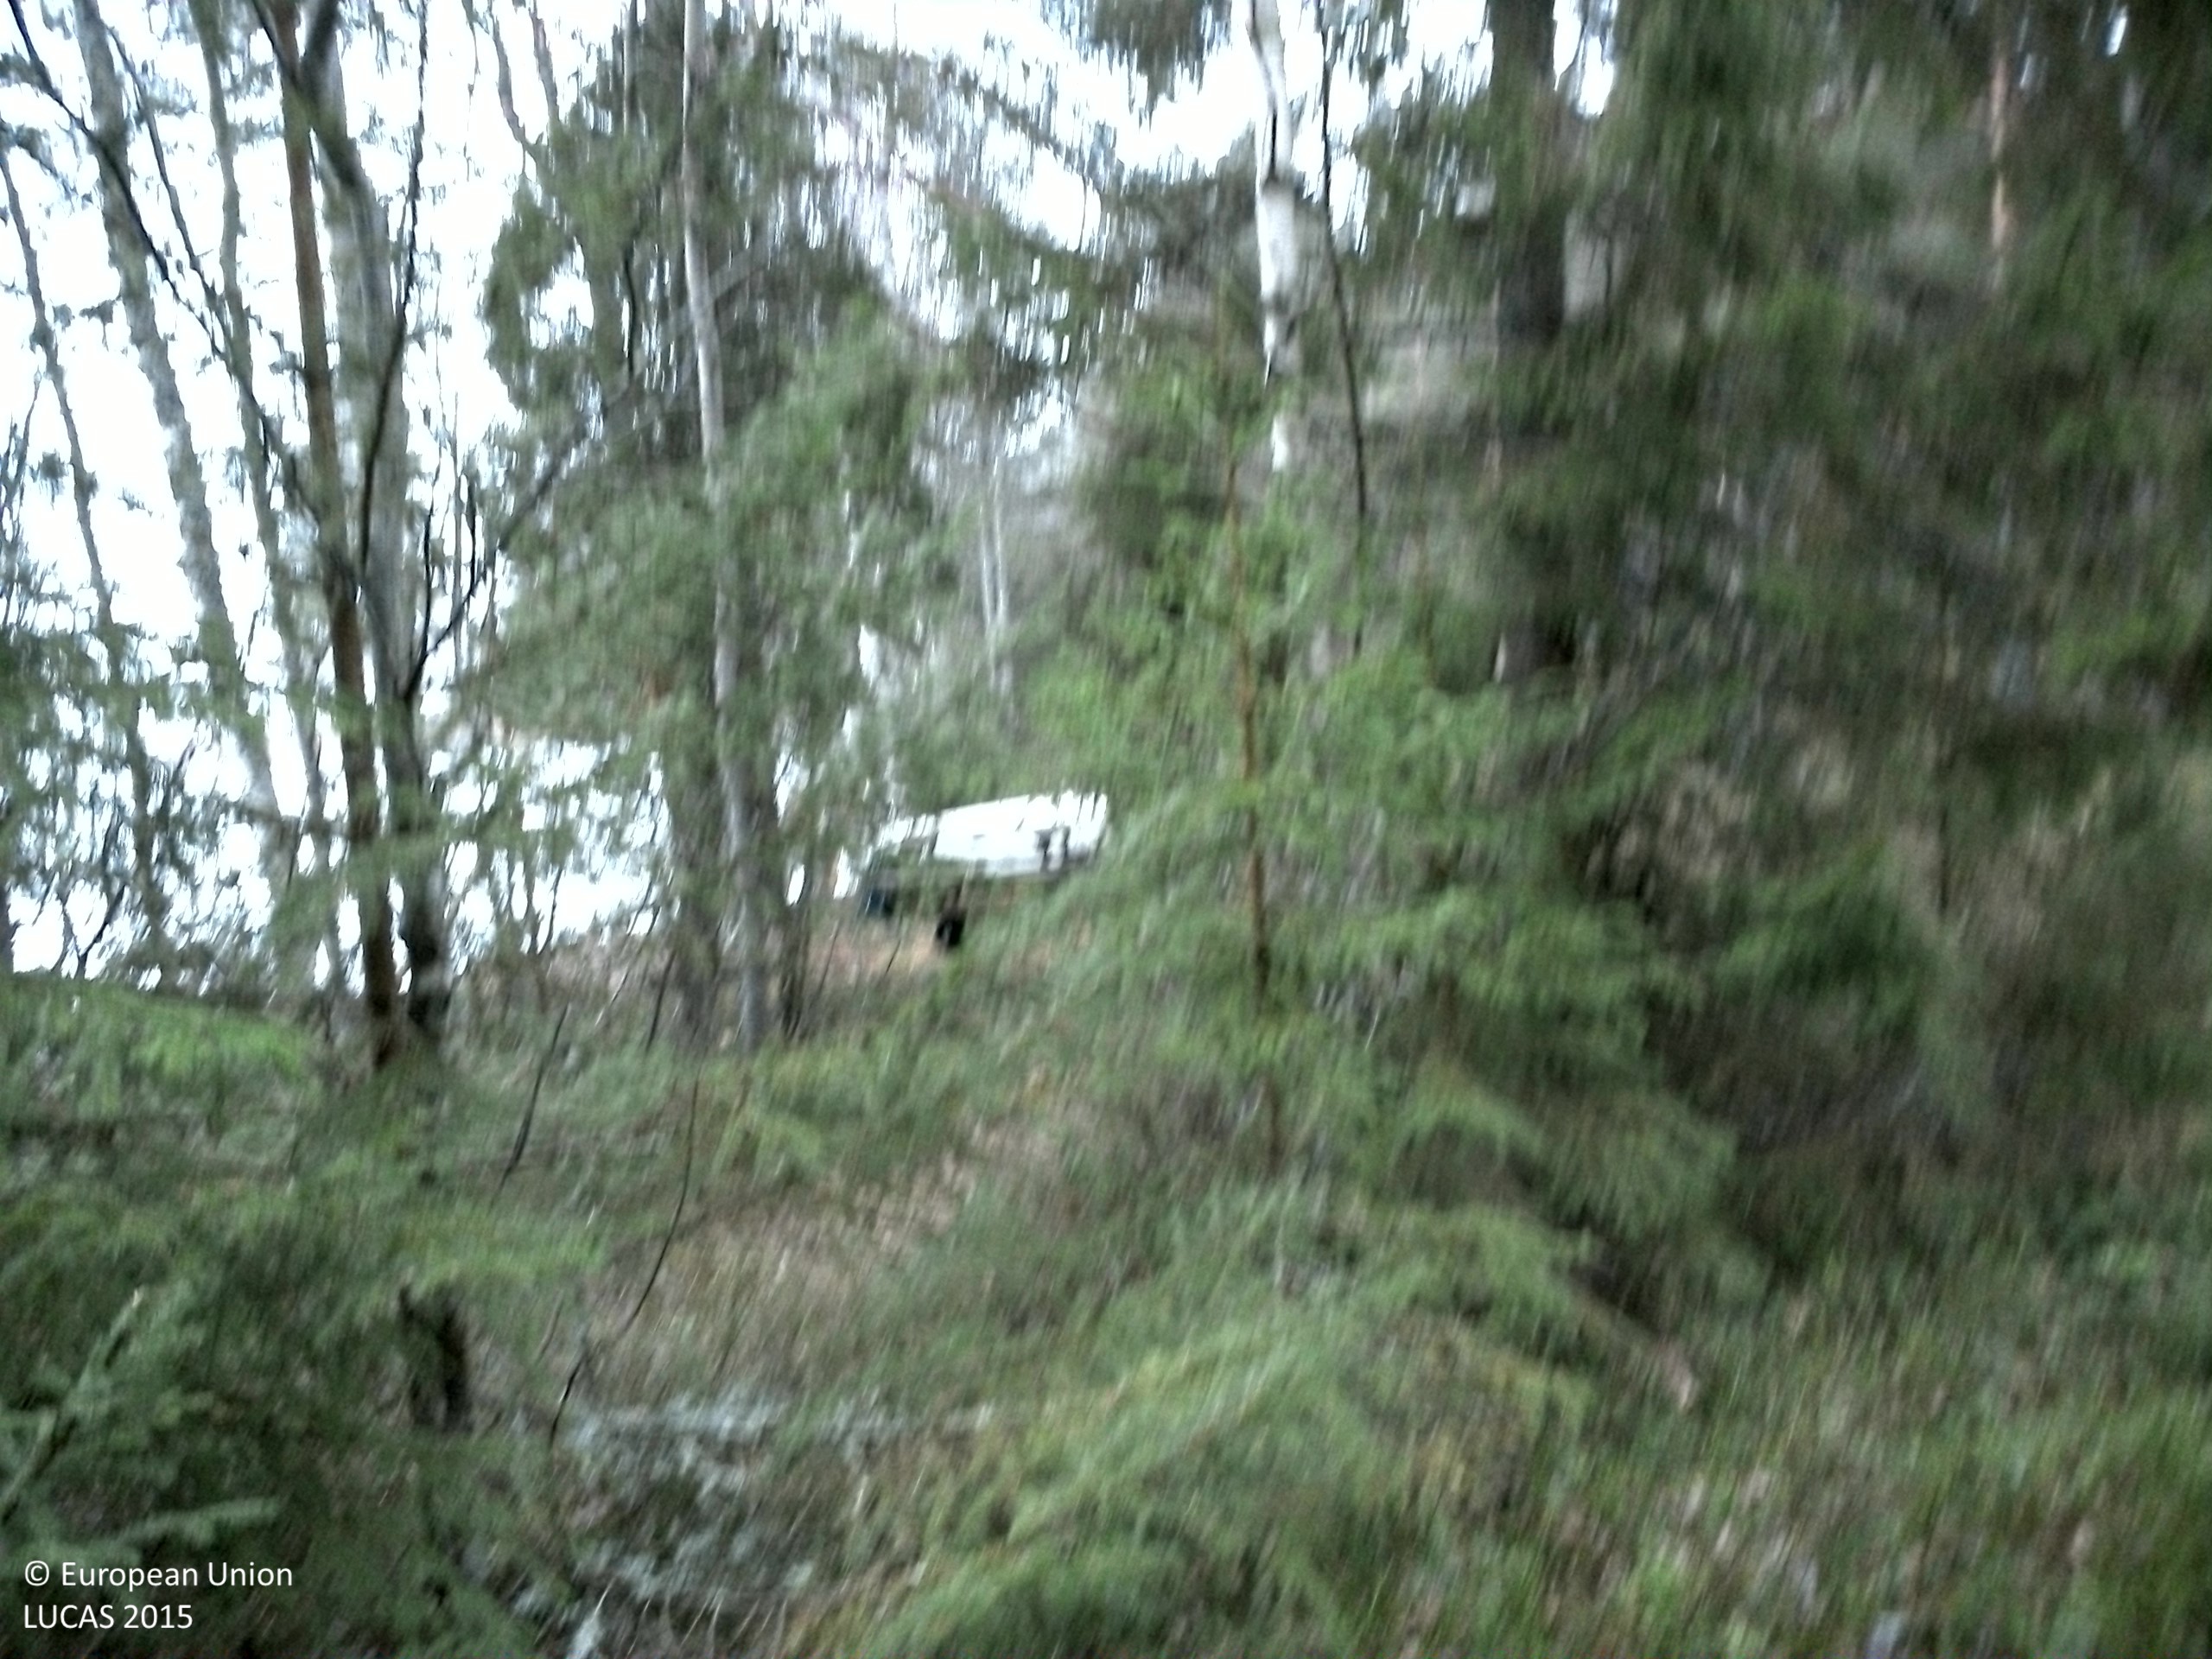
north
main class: Woodland
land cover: Other coniferous woodland
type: boreal forest
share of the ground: 50 - 75 %
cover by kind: coniferous forest trees 60 %, shrubs 25 %, lichens and mosses 10 %, broadleaved forest trees 5 %
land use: Forestry
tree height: > 5 m
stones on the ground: < 10 %
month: November
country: SE
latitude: 60.3513
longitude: 16.6041
